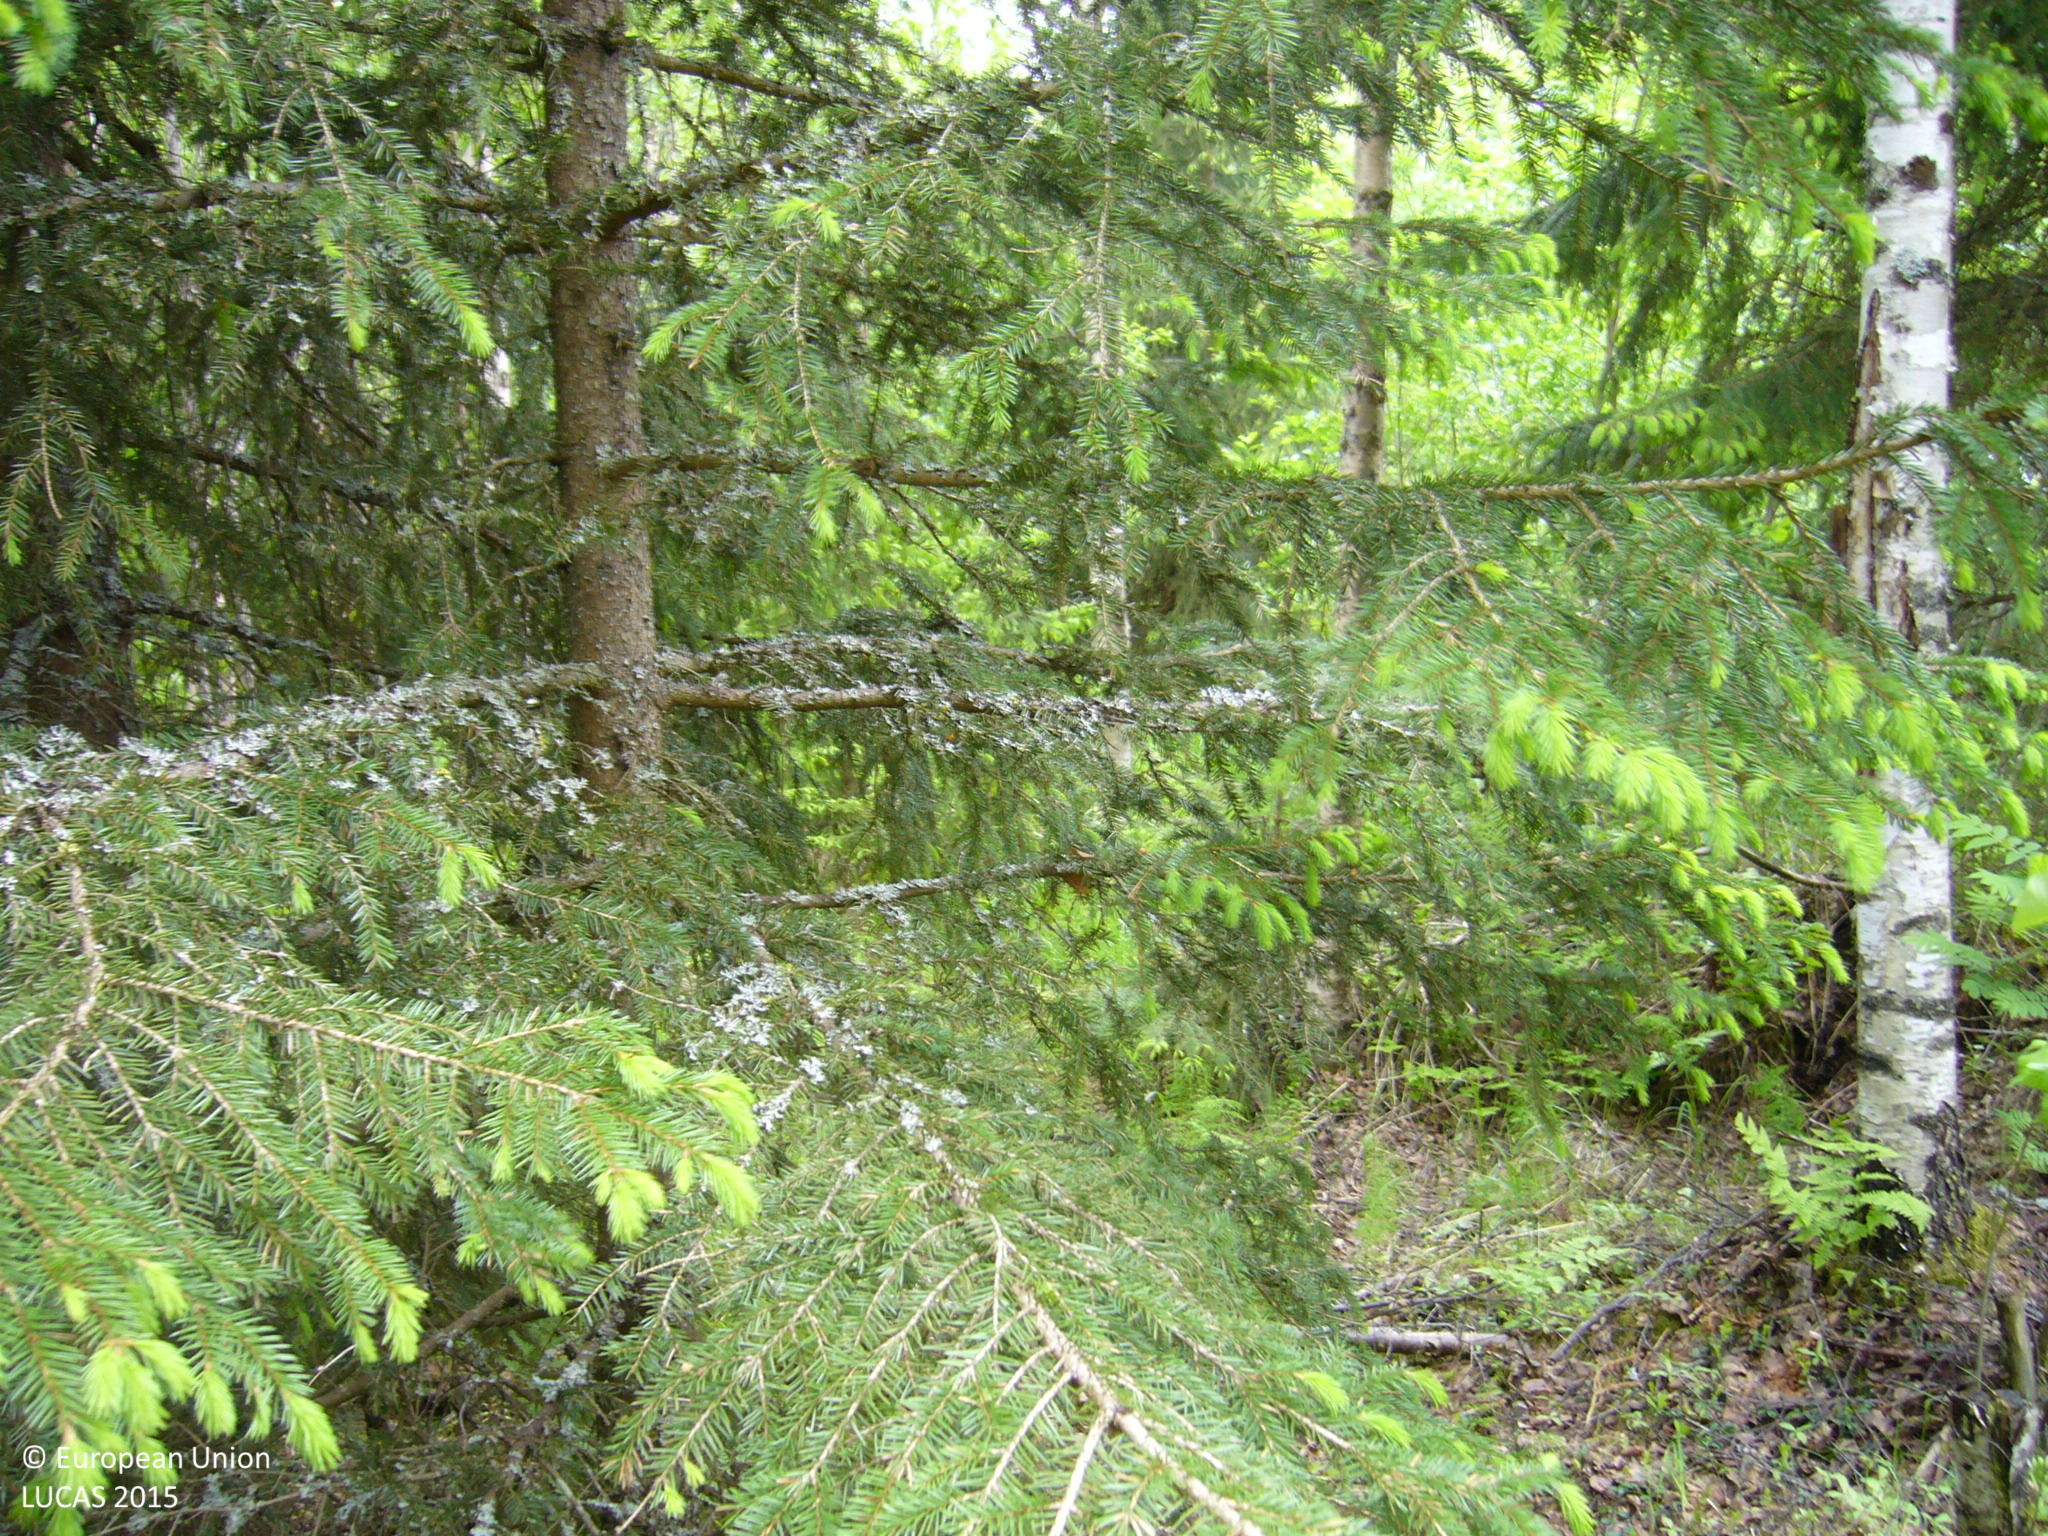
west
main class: Woodland
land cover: Spruce dominated mixed woodland
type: boreal forest
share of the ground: > 75 %
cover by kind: coniferous forest trees 50 %, broadleaved forest trees 40 %, shrubs 10 %
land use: Forestry
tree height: > 5 m
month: June
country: FI
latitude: 63.5463
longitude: 26.8147
